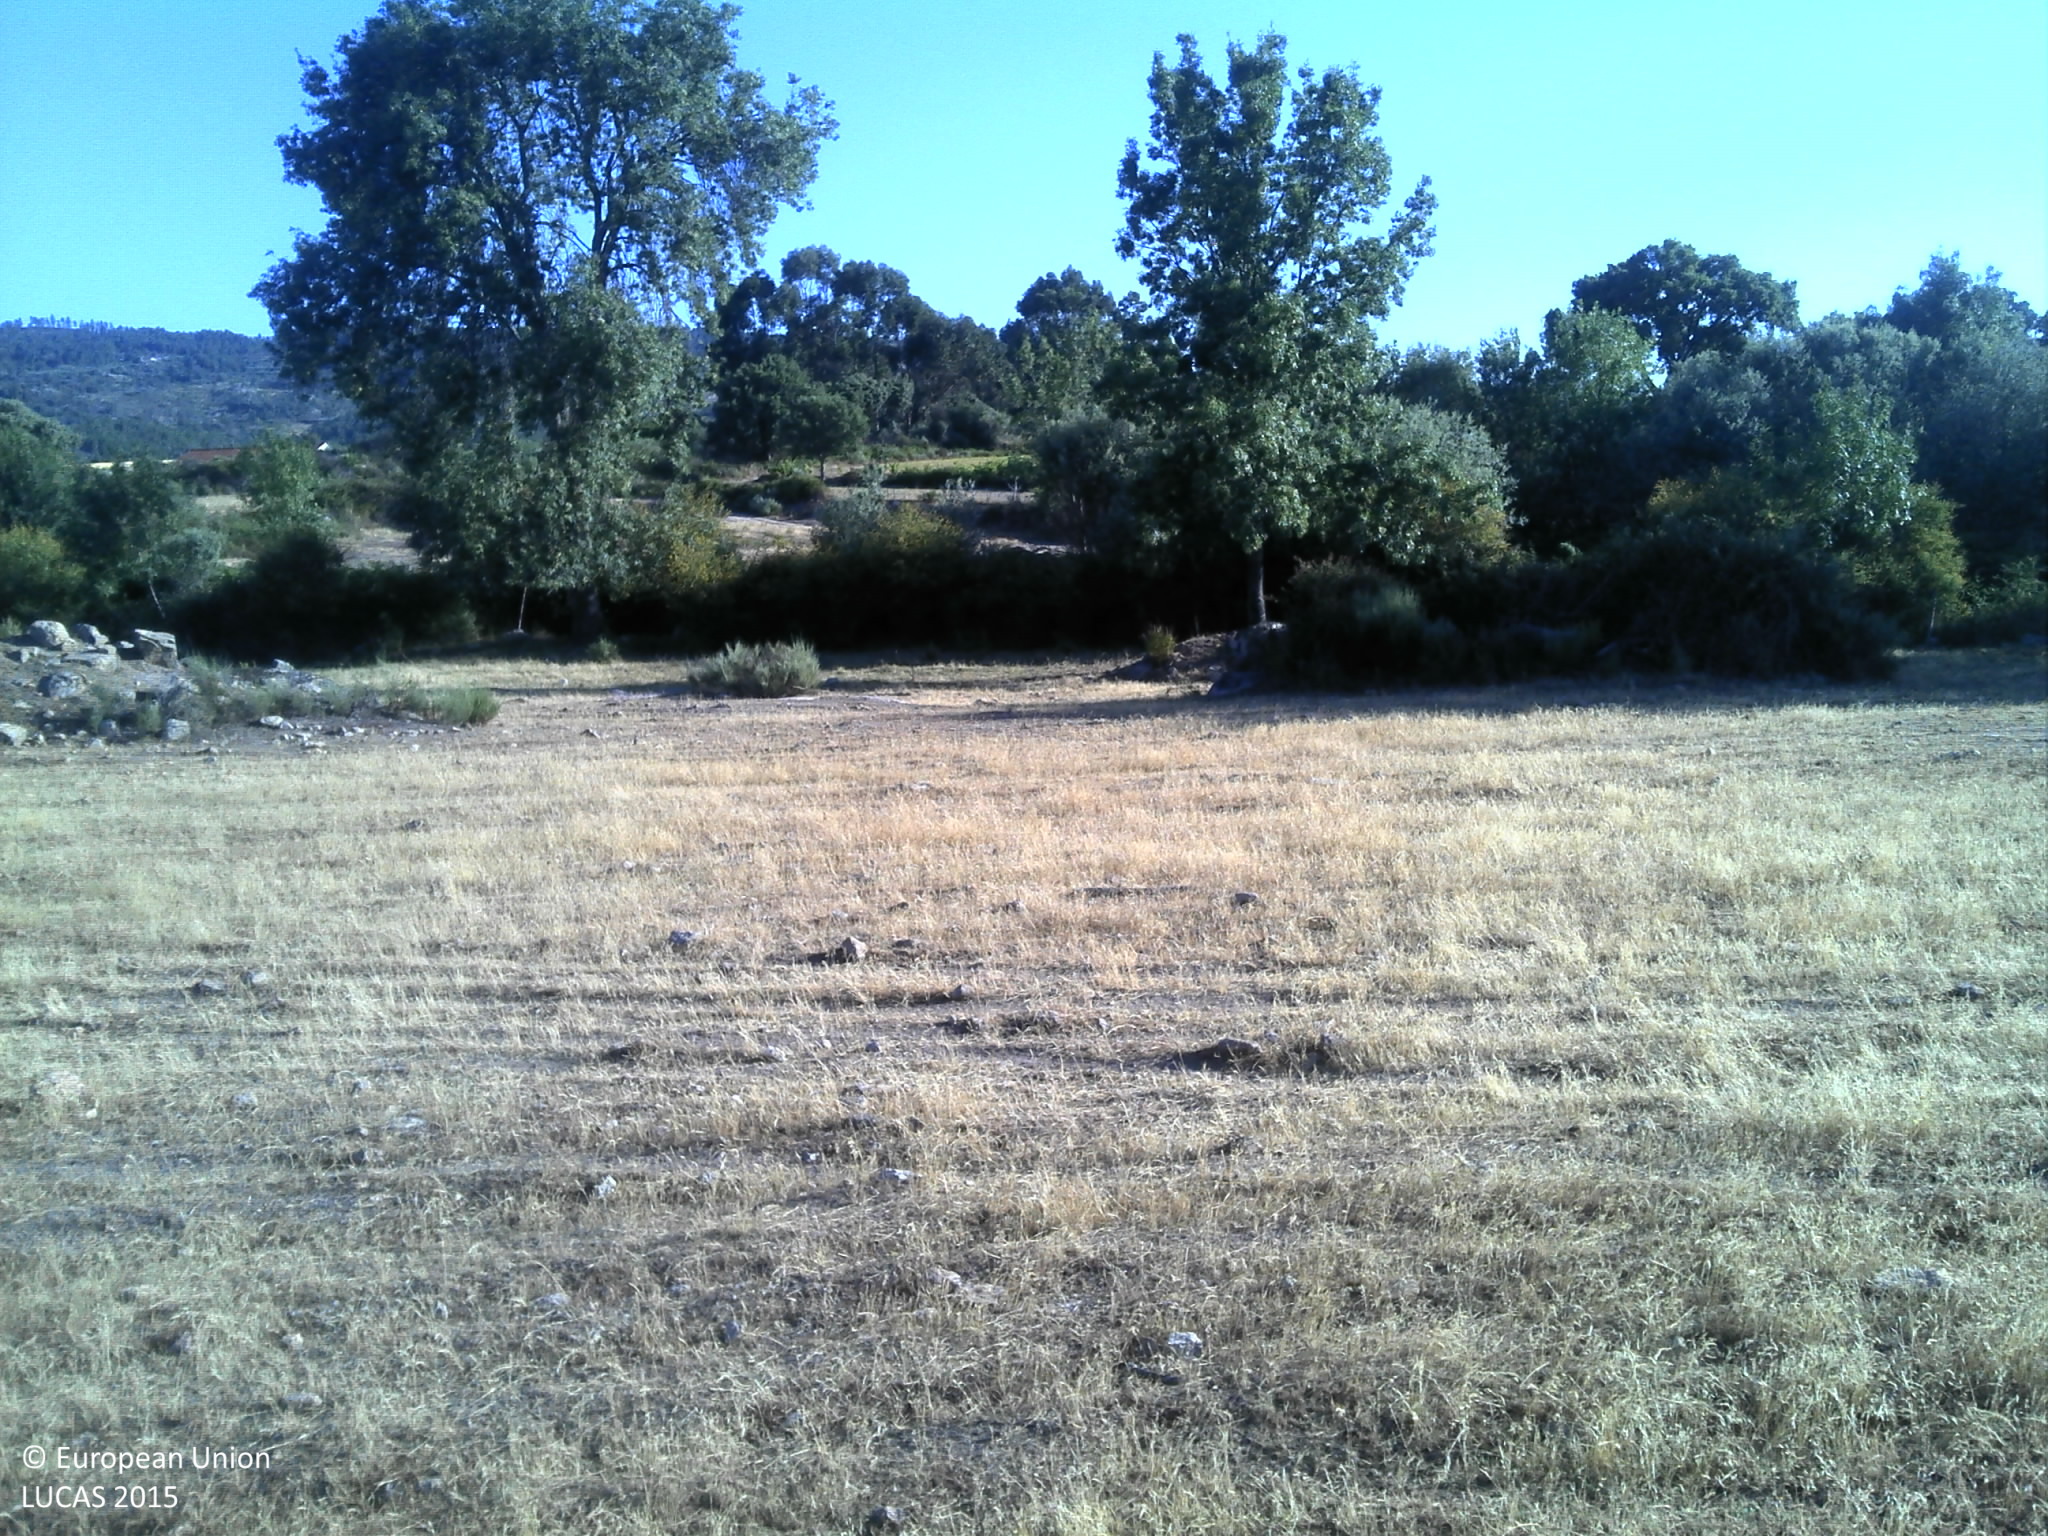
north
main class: Shrubland
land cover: Shrubland without tree cover
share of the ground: 50 - 75 %
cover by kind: shrubs 70 %, herbaceous plants 10 %, unconsolidated bare surface 10 %
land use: Agriculture (excluding fallow land and kitchen gardens)
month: June
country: PT
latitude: 40.1131
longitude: -7.3356
